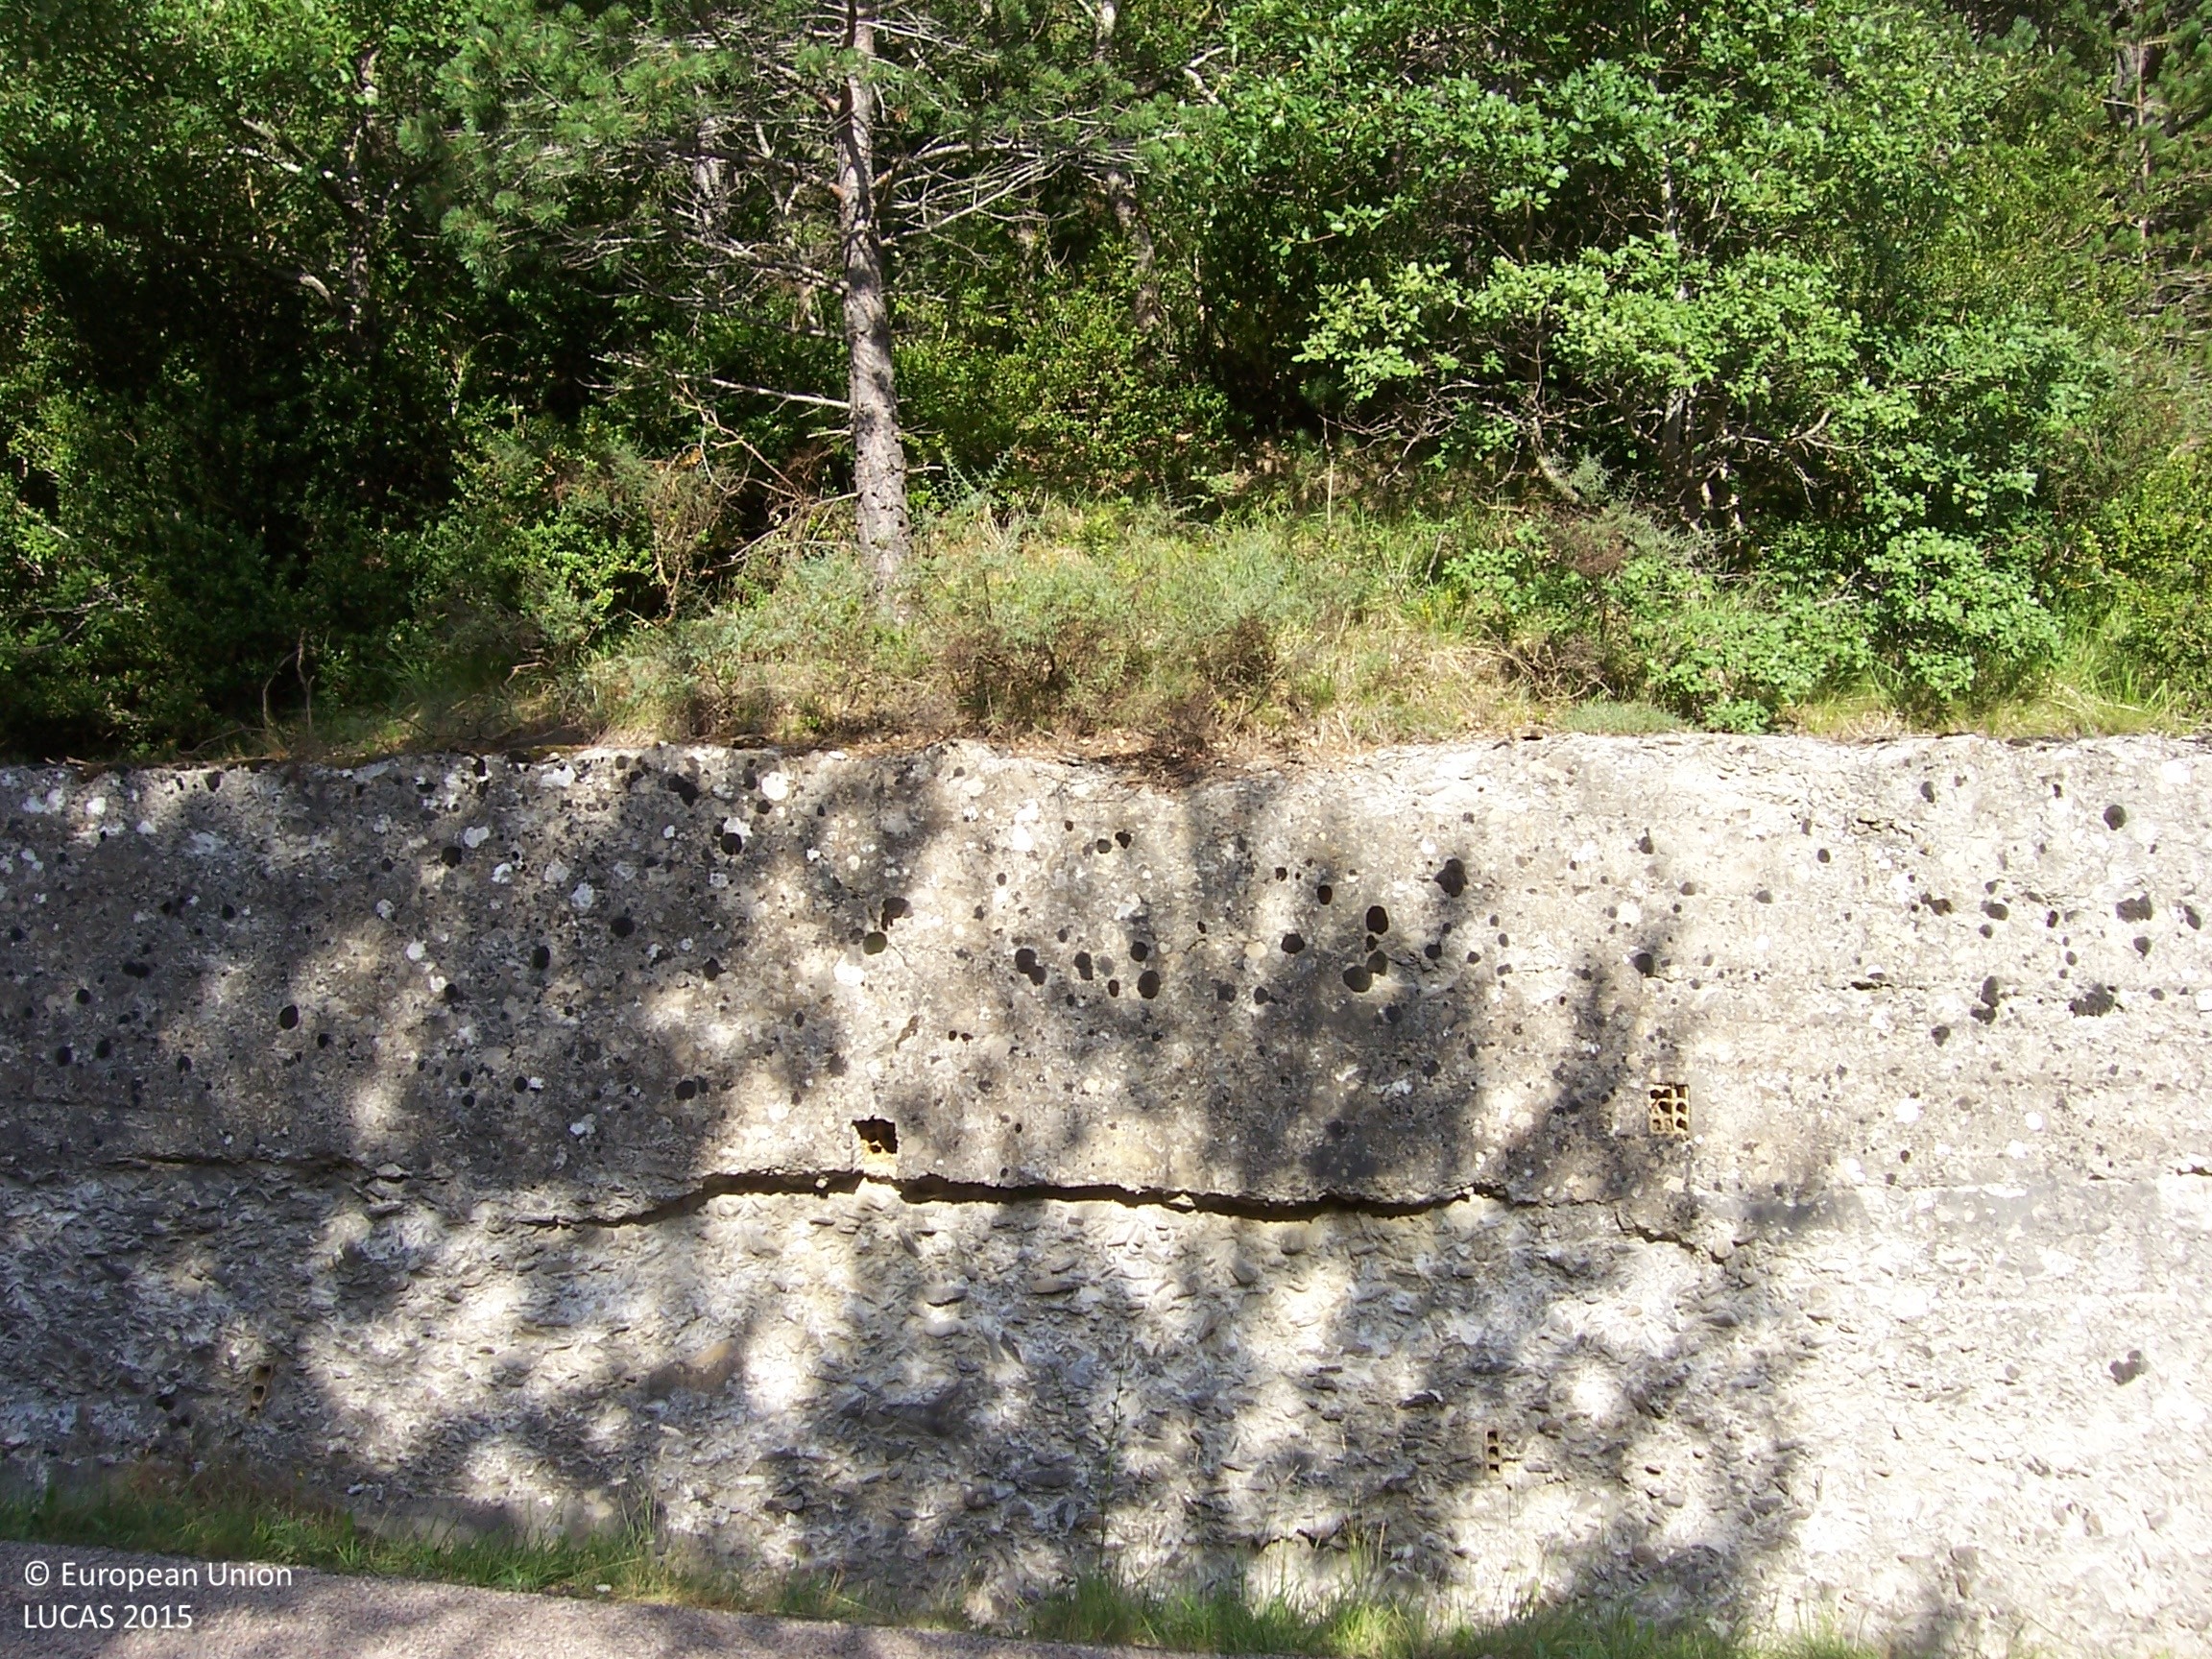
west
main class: Woodland
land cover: Pine dominated mixed woodland
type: coniferous forest of the mediterranean region
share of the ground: > 75 %
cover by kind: coniferous forest trees 75 %, broadleaved forest trees 25 %
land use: Semi-natural and natural areas not in use
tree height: > 5 m
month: August
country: ES
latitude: 42.5270
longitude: -0.4836
